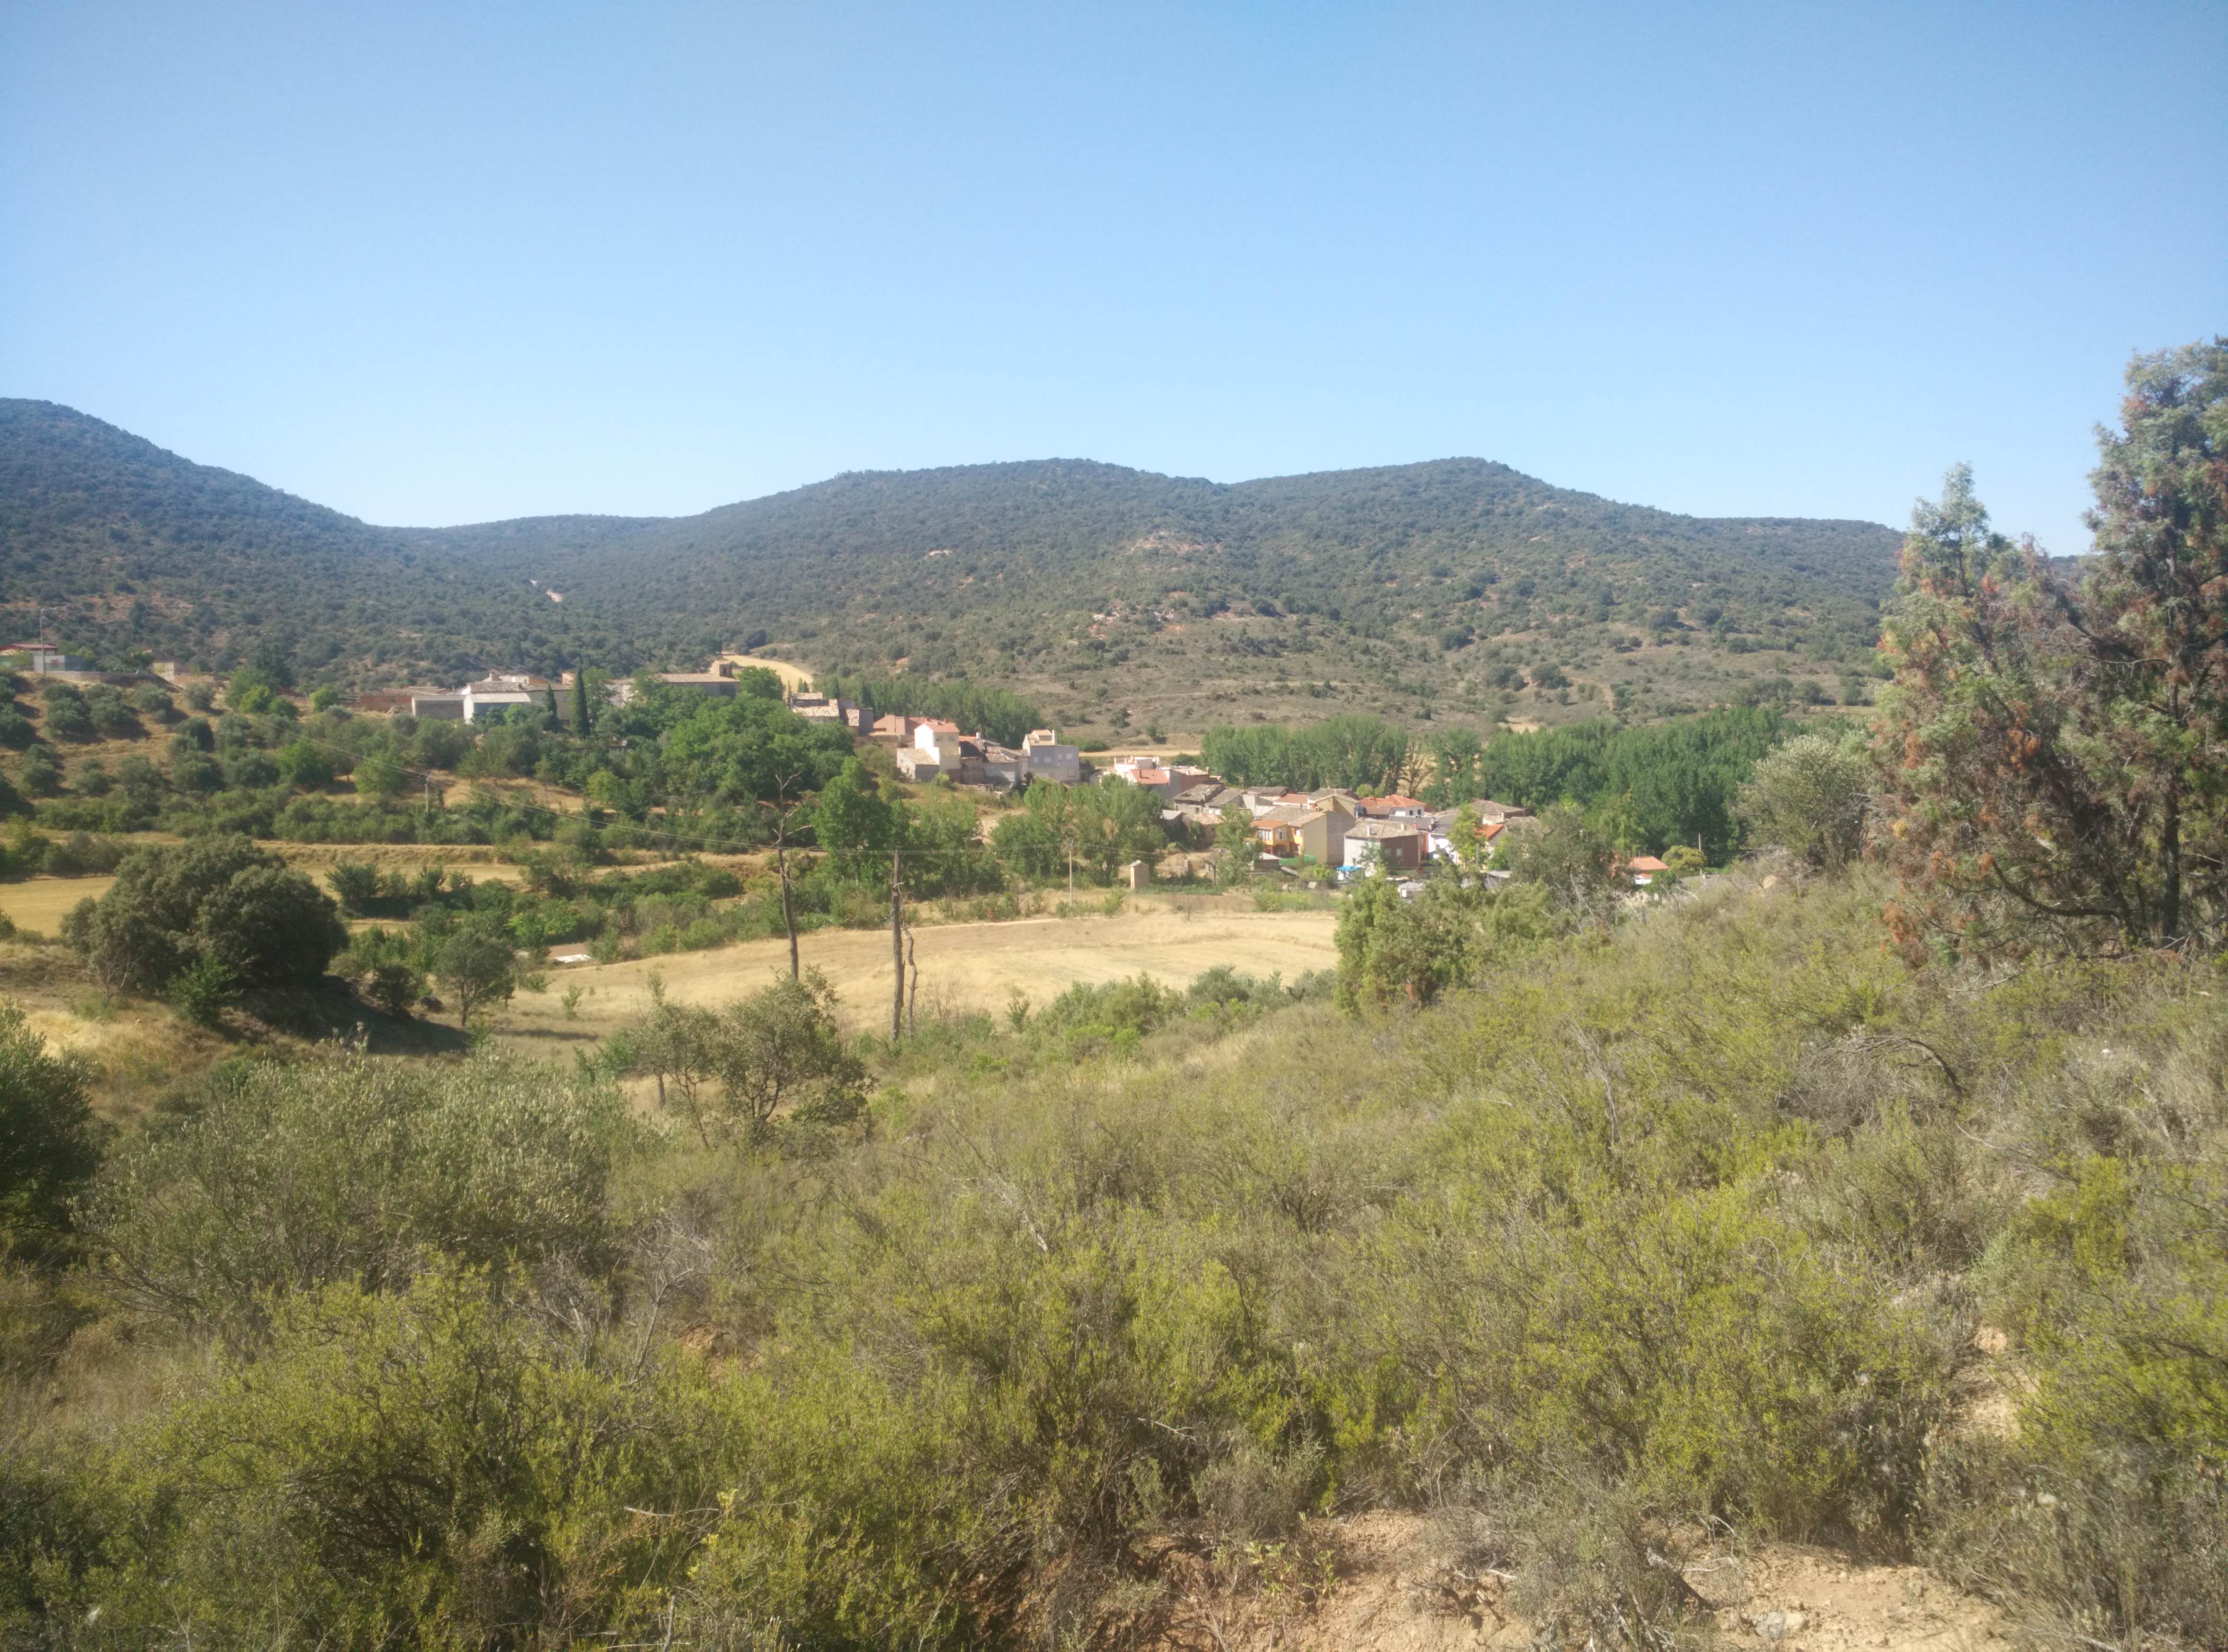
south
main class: Cropland
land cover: Olive groves
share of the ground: 10 - 25 %
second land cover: Shrubland without tree cover
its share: 50 - 75 %
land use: Agriculture (excluding fallow land and kitchen gardens)
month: July
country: ES
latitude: 40.7378
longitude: -2.8316
